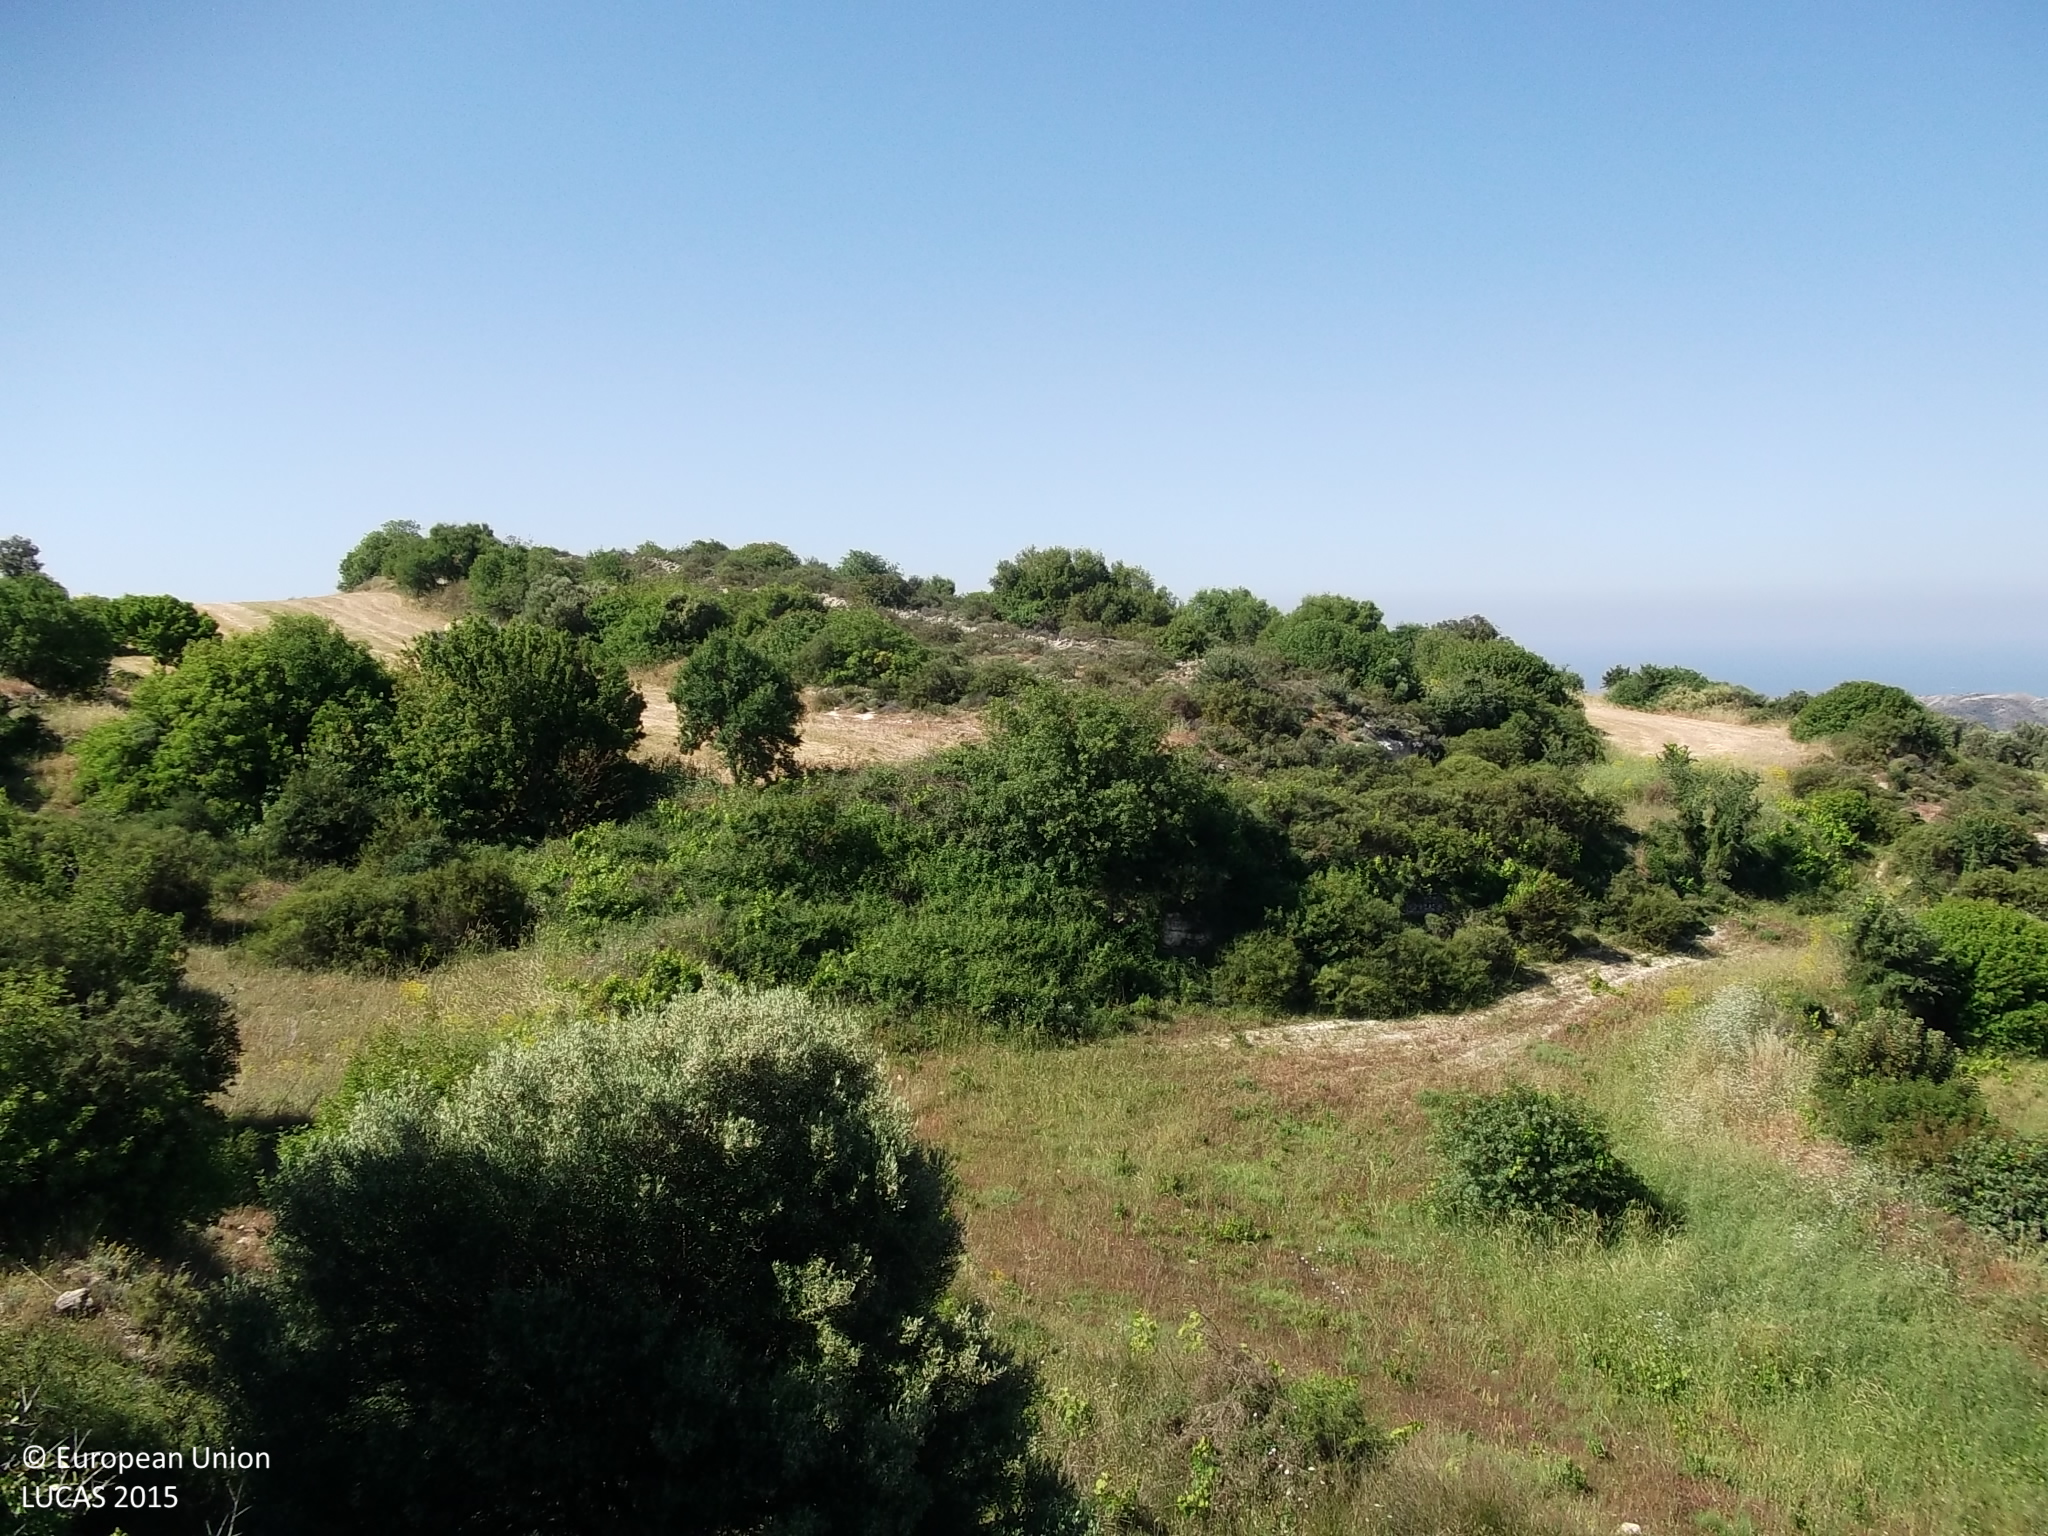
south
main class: Shrubland
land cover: Shrubland with sparse tree cover
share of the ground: > 75 %
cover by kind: shrubs 75 %, unconsolidated bare surface 20 %, broadleaved forest trees 5 %
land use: Semi-natural and natural areas not in use
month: May
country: CY
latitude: 34.7967
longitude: 32.5450
